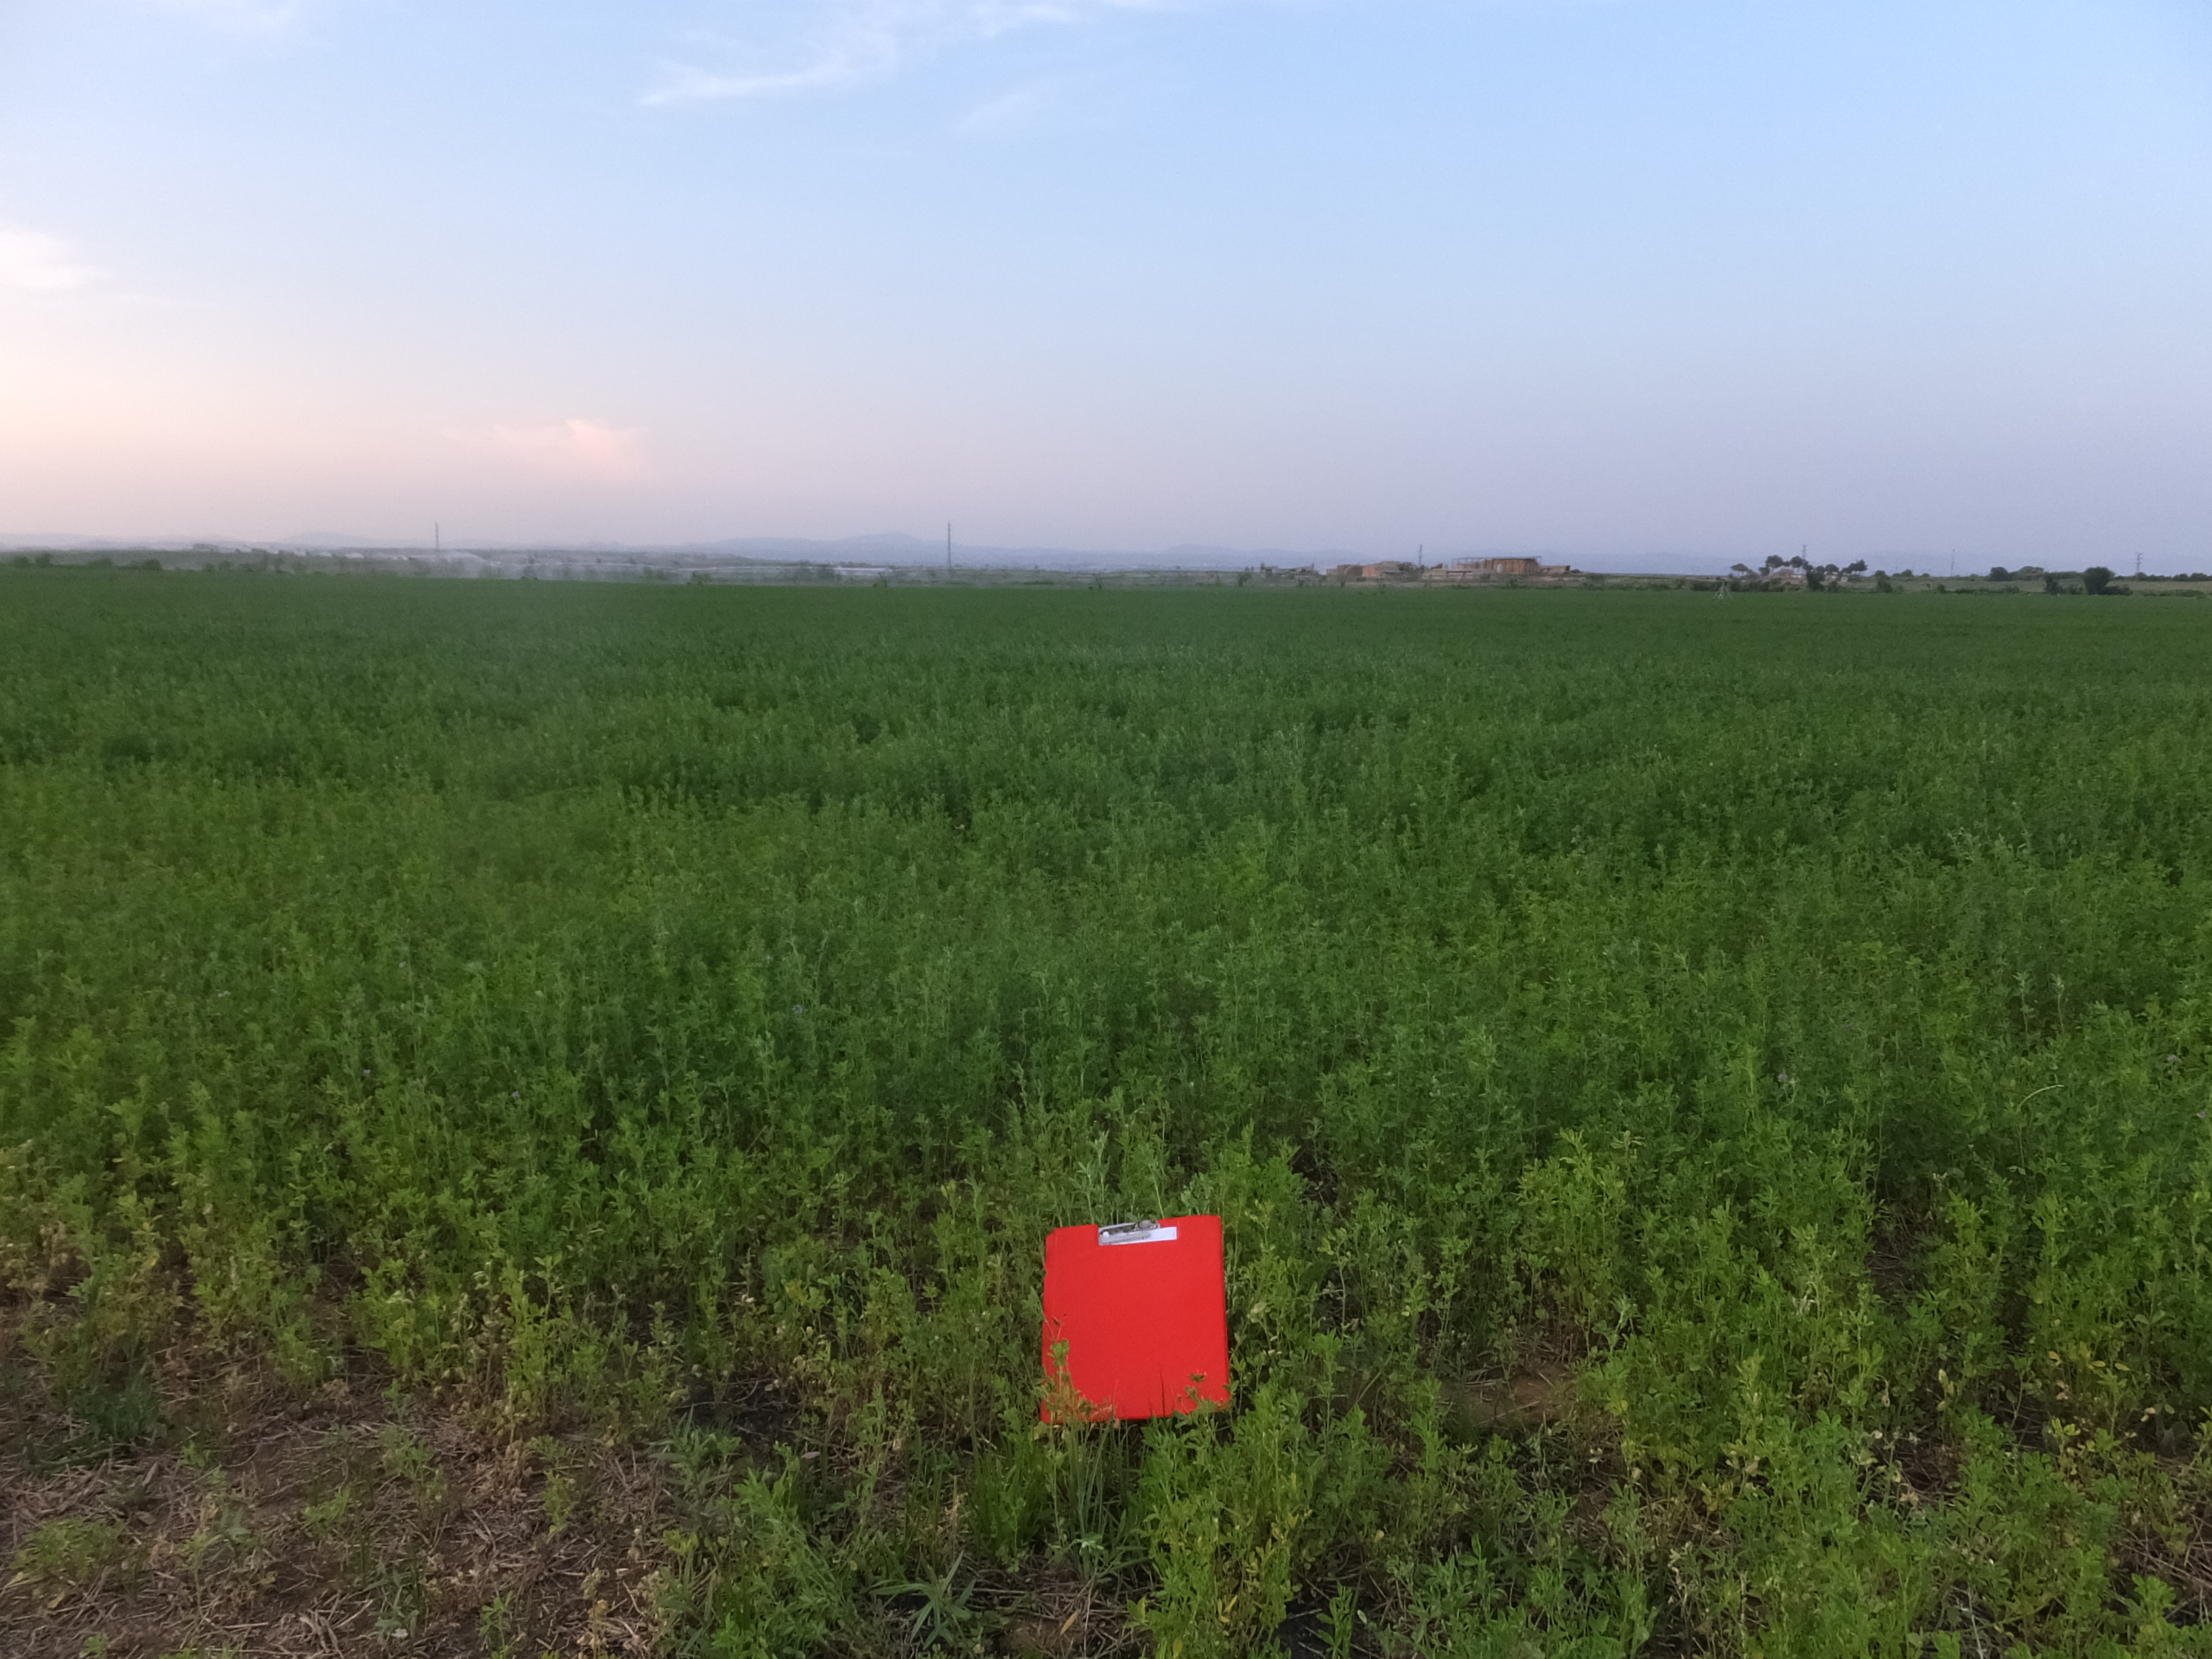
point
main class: Cropland
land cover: Lucerne
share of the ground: > 75 %
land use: Agriculture (excluding fallow land and kitchen gardens)
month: July
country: ES
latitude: 41.7717
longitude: 0.3250
